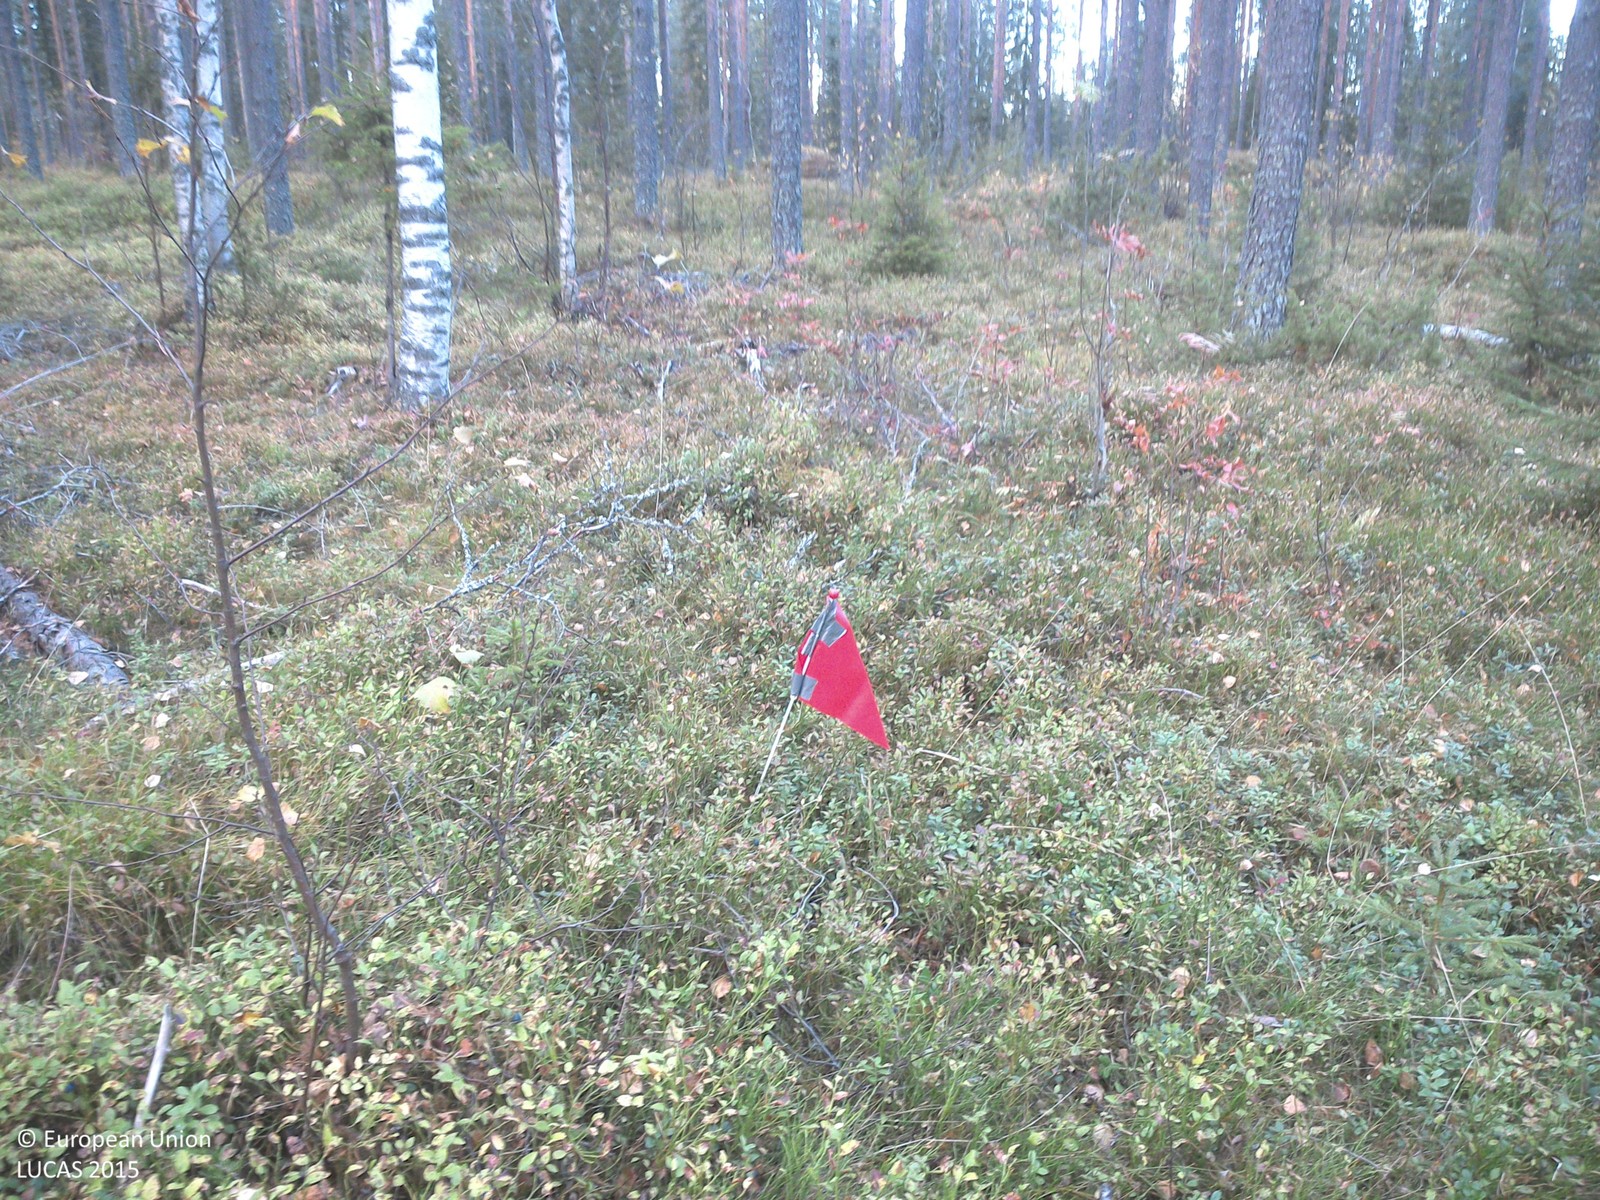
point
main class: Woodland
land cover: Pine dominated mixed woodland
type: boreal forest
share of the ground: 25 - 50 %
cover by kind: shrubs 50 %, coniferous forest trees 30 %, broadleaved forest trees 20 %
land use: Forestry
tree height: > 5 m
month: October
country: SE
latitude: 63.8676
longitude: 19.9304
